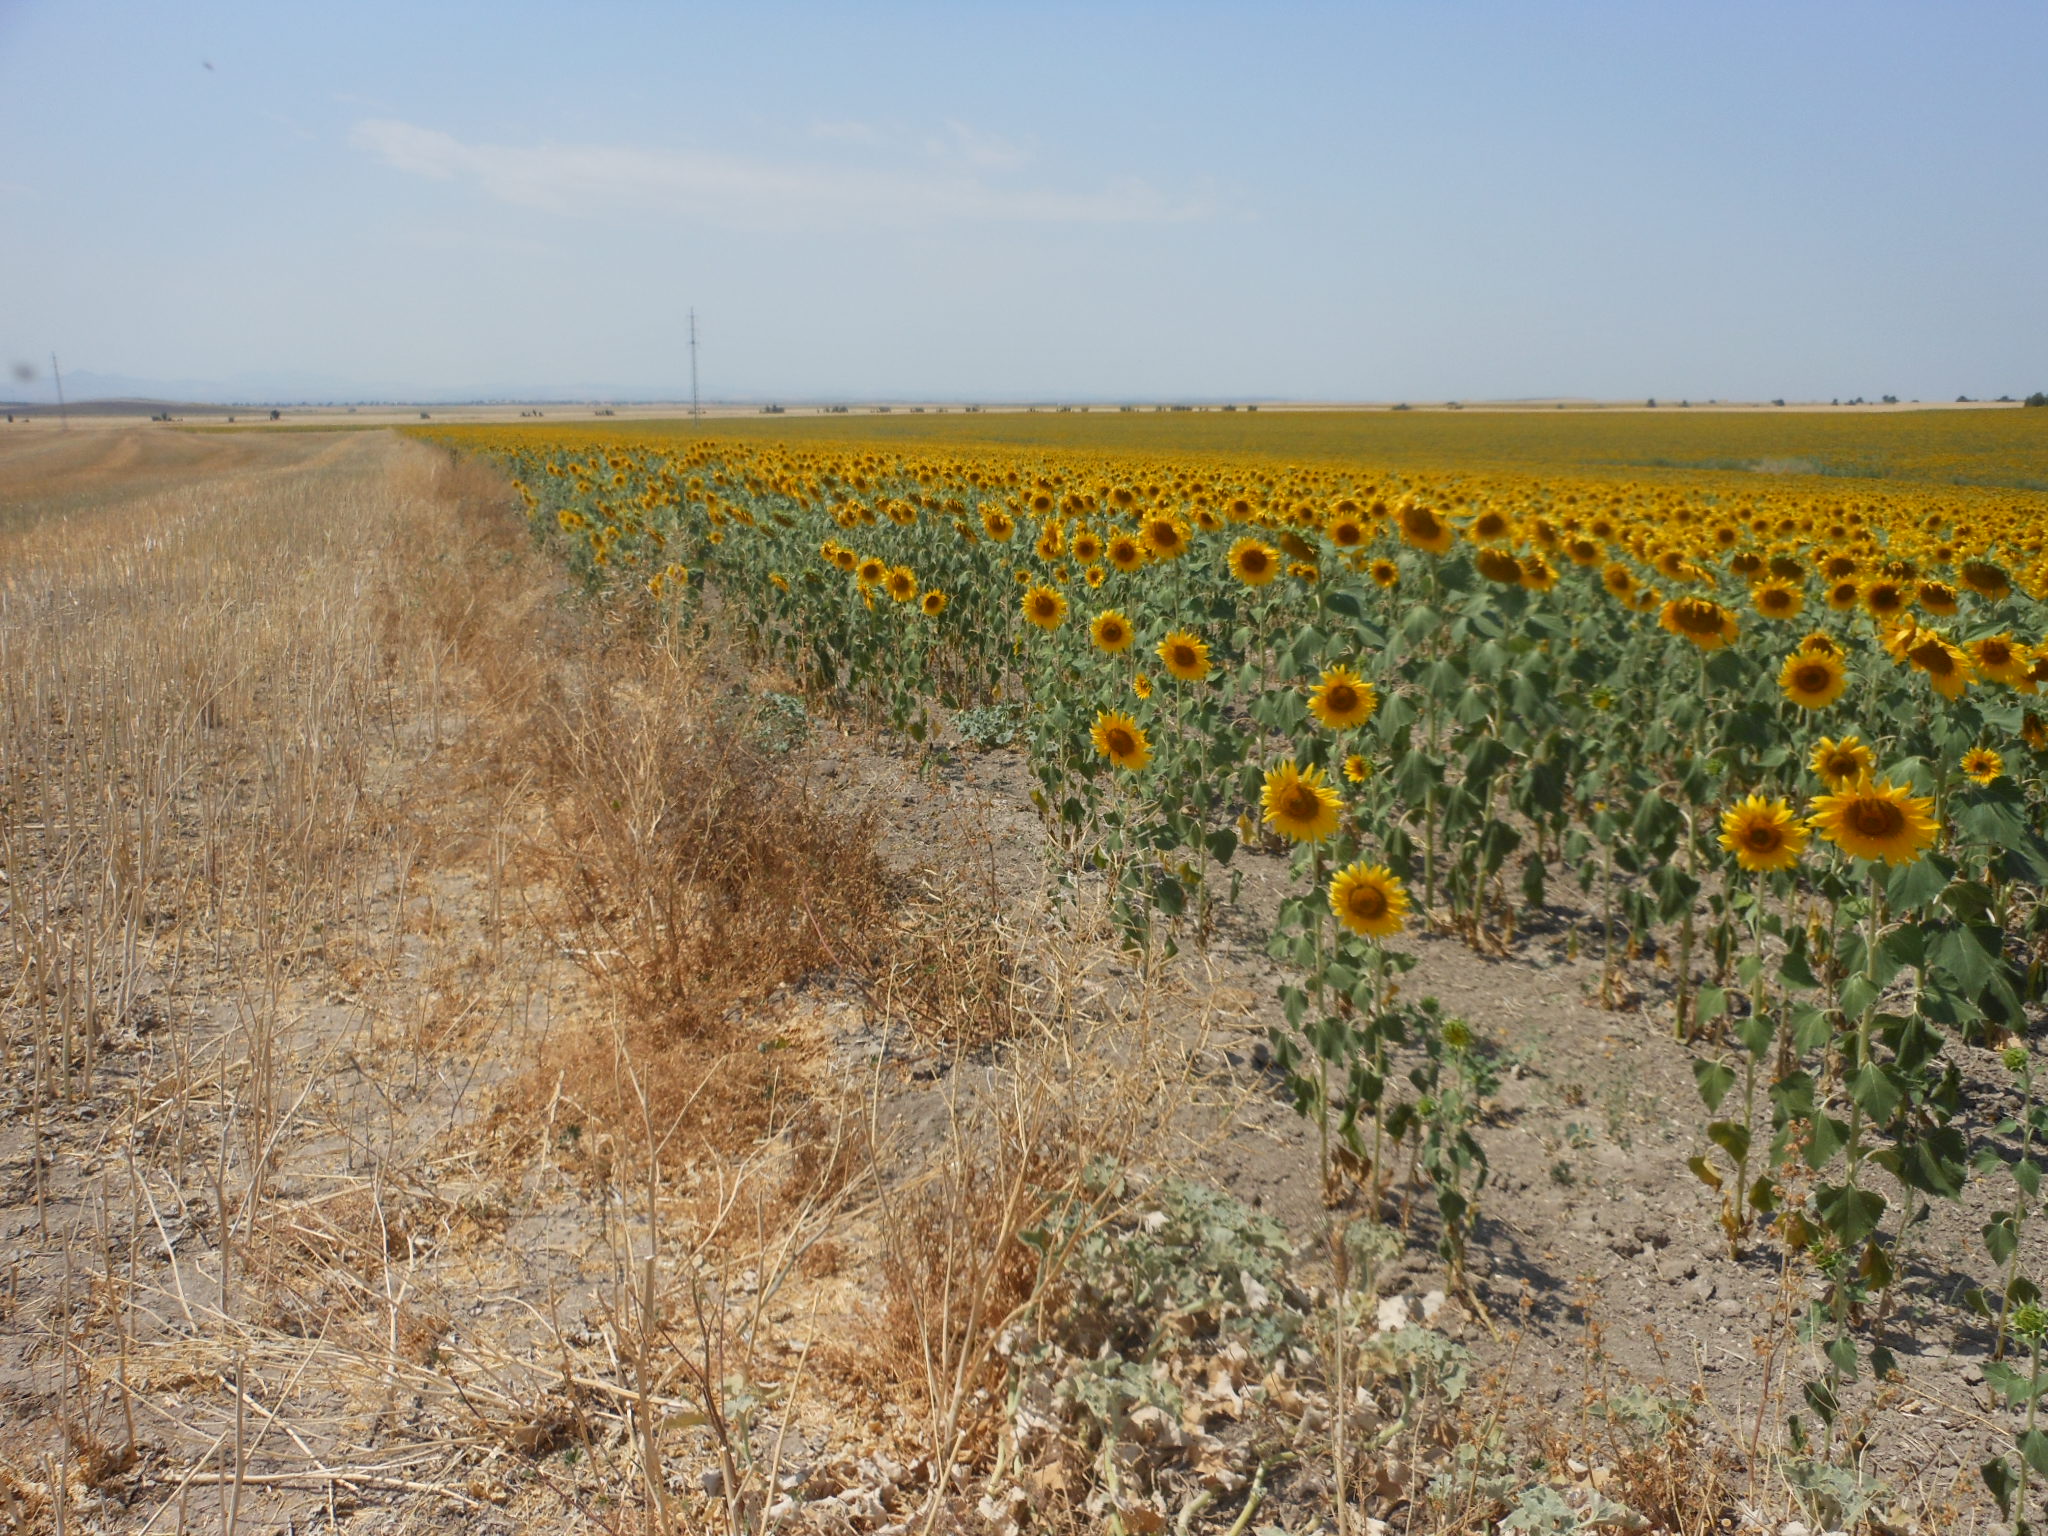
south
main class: Cropland
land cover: Sunflower
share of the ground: 50 - 75 %
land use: Agriculture (excluding fallow land and kitchen gardens)
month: June
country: ES
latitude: 37.4328
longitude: -5.1212
